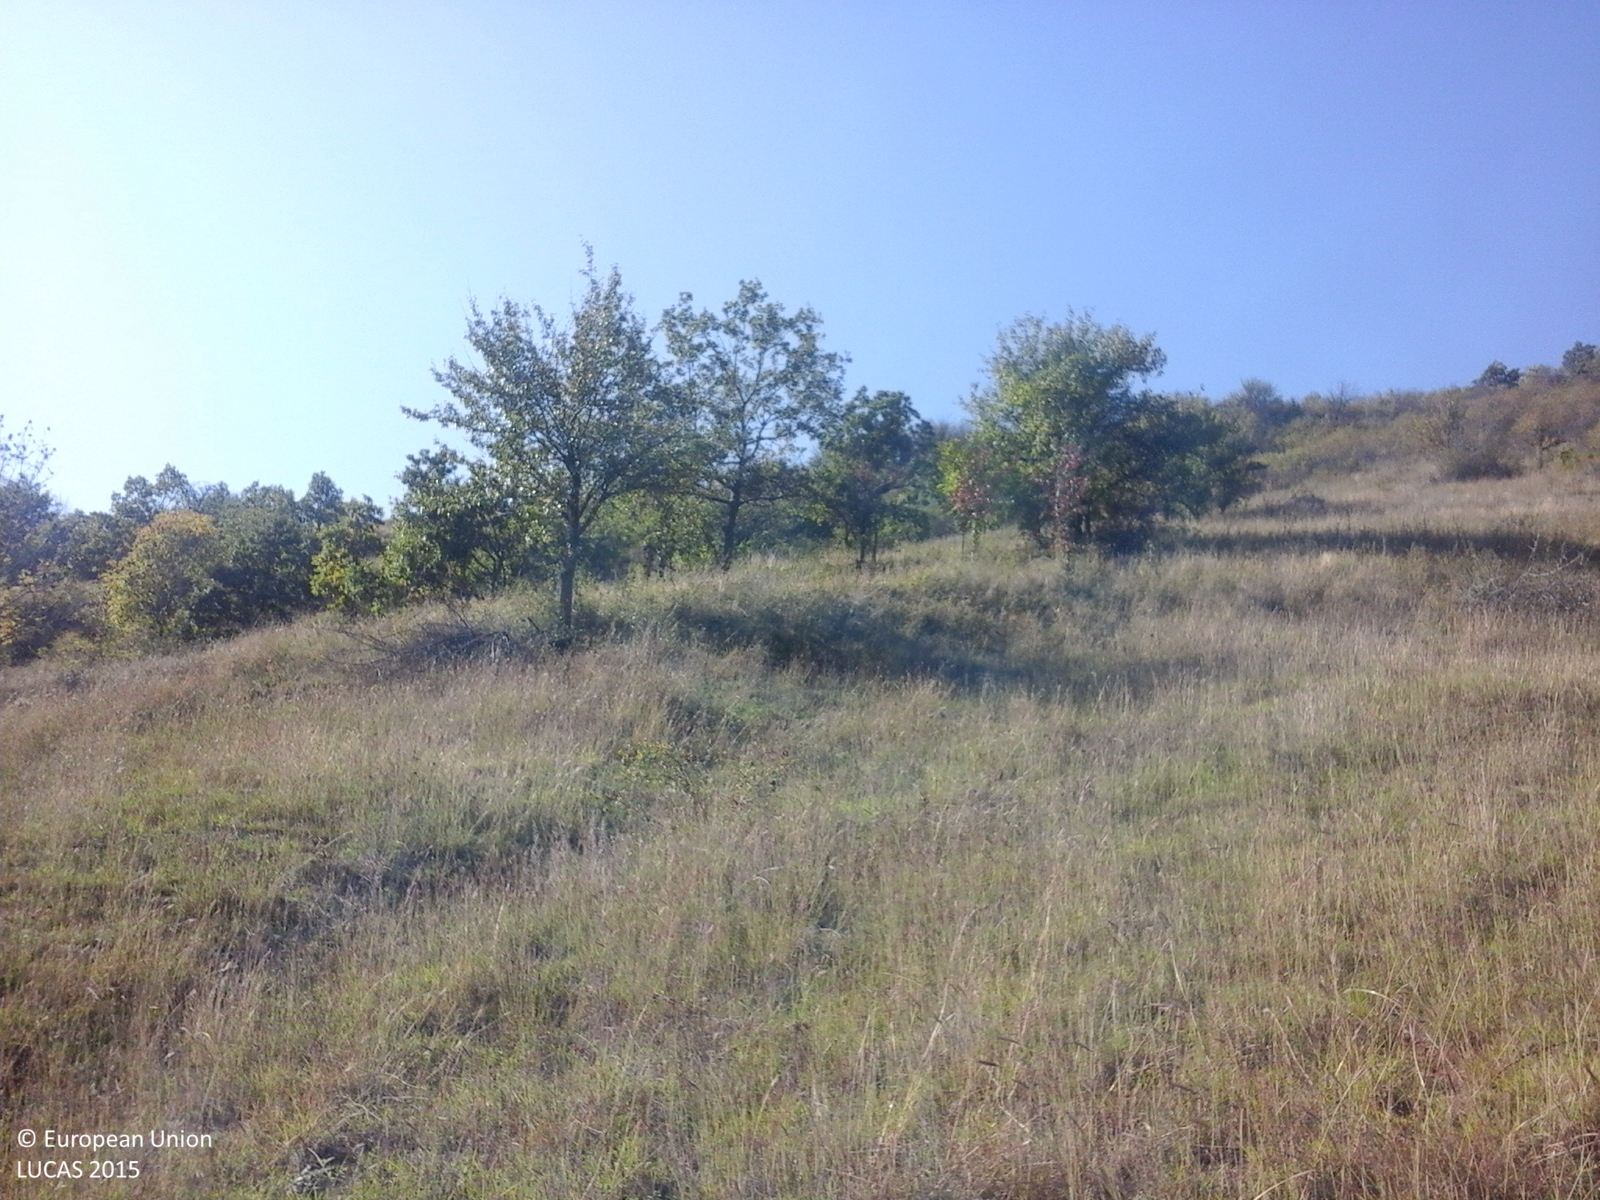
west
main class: Grassland
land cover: Grassland with sparse tree/shrub cover
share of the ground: > 75 %
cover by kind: herbaceous plants 85 %, shrubs 10 %, broadleaved forest trees 5 %
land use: Fallow land
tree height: < 5 m
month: October
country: RO
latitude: 46.5343
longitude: 23.6169
